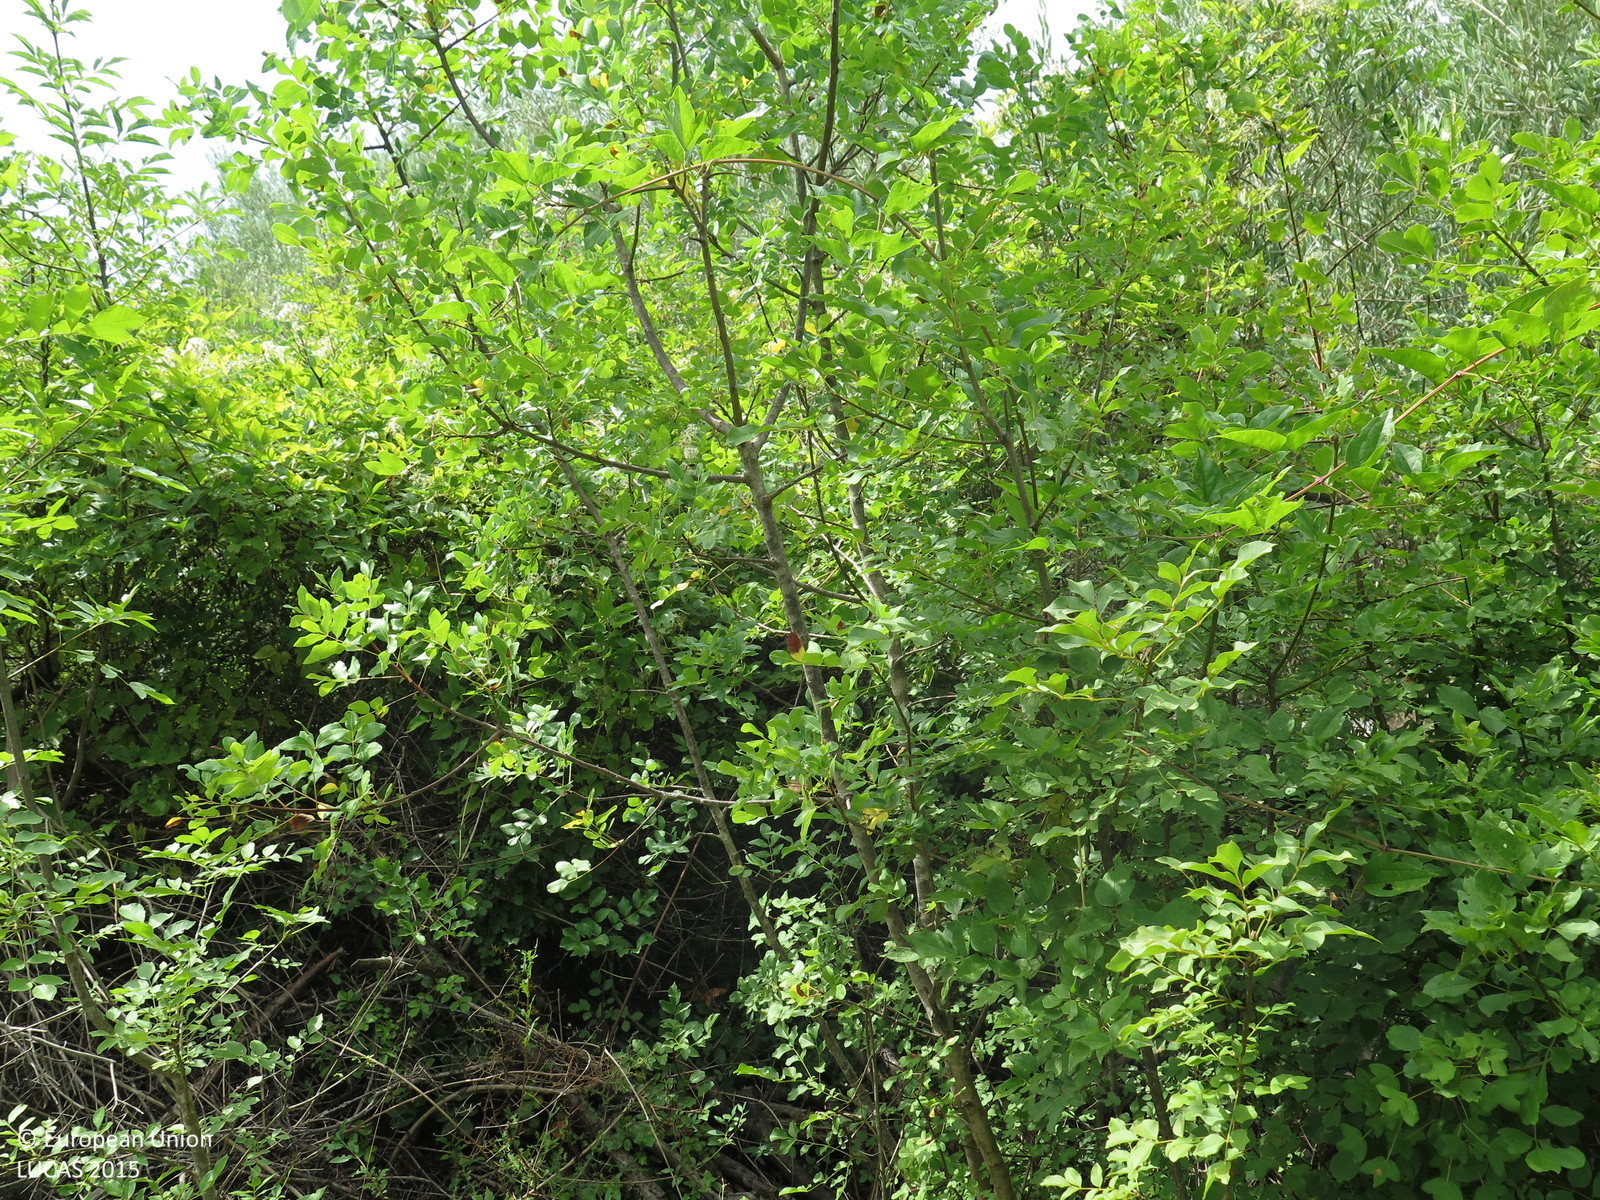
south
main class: Woodland
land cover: Broadleaved woodland
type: thermophilous deciduous forest
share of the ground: > 75 %
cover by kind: broadleaved forest trees 90 %, shrubs 5 %, herbaceous plants 5 %
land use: Semi-natural and natural areas not in use
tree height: > 5 m
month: August
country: HR
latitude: 45.1498
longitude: 14.6371
